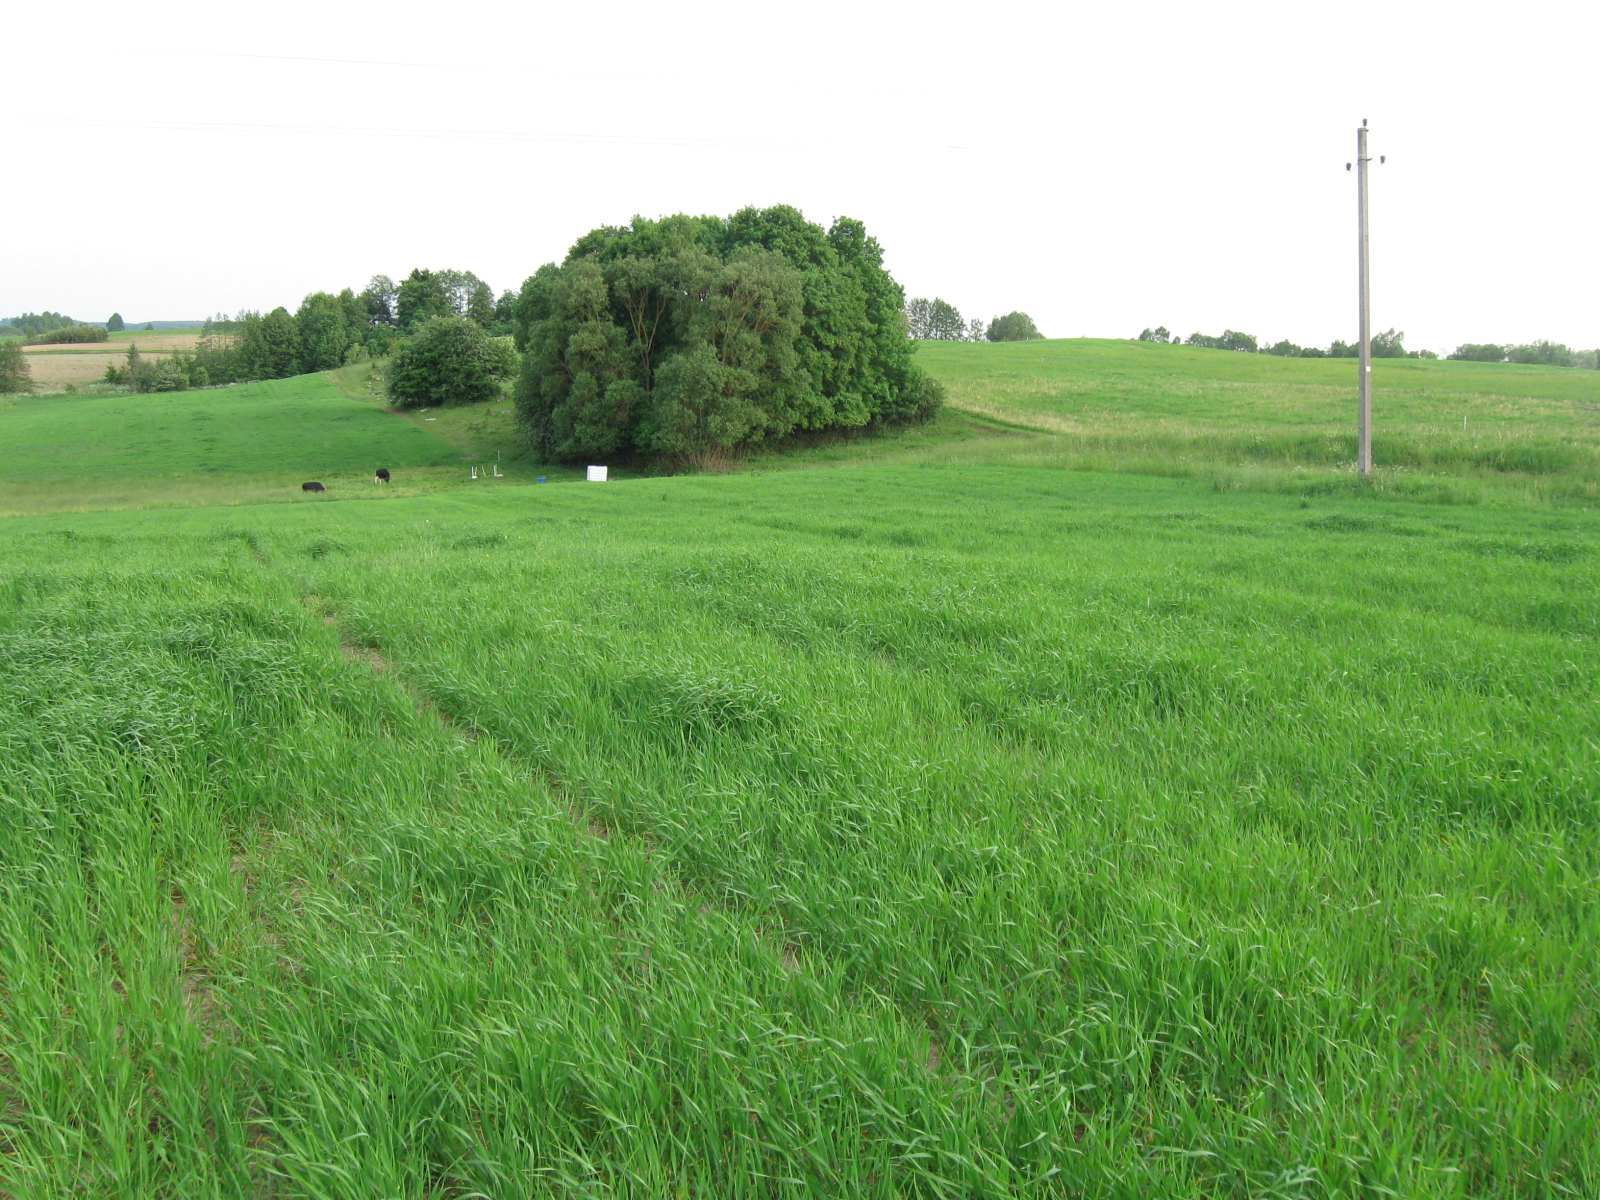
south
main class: Cropland
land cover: Barley
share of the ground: > 75 %
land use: Agriculture (excluding fallow land and kitchen gardens)
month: June
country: LT
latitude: 54.2675
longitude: 23.6431
